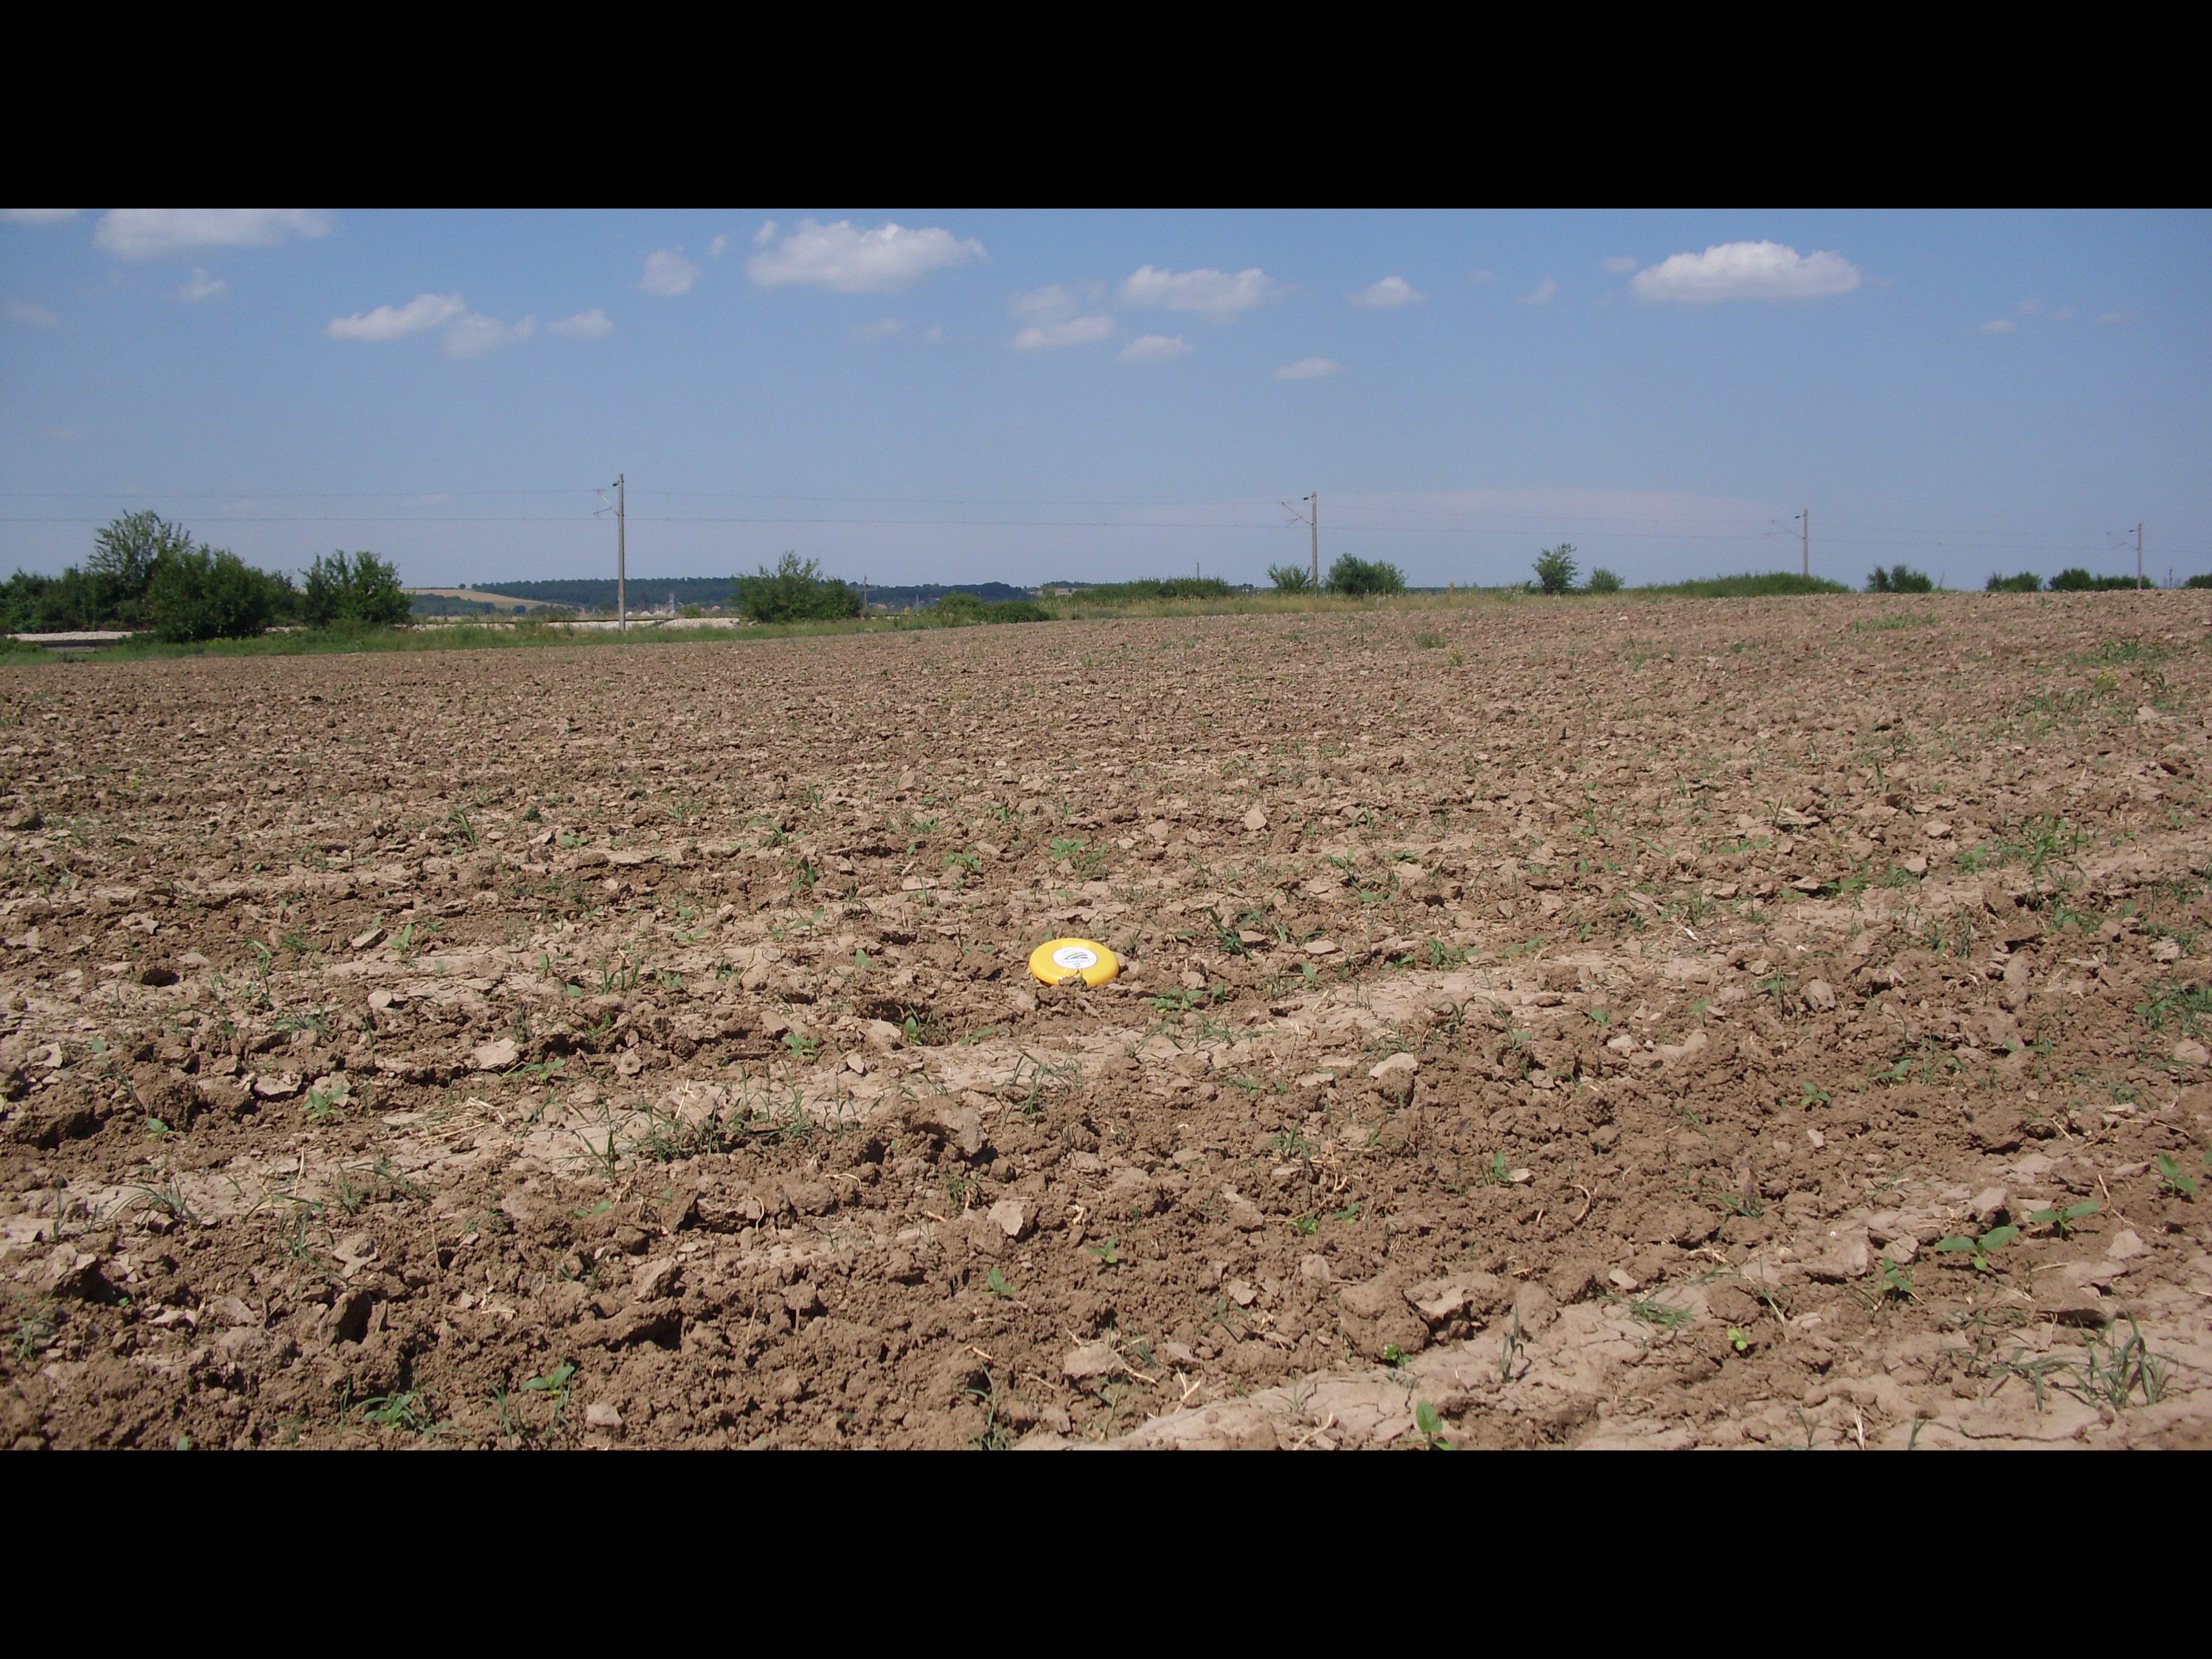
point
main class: Cropland
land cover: Sunflower
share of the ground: < 10 %
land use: Agriculture (excluding fallow land and kitchen gardens)
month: June
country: BG
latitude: 43.4711
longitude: 23.3054
